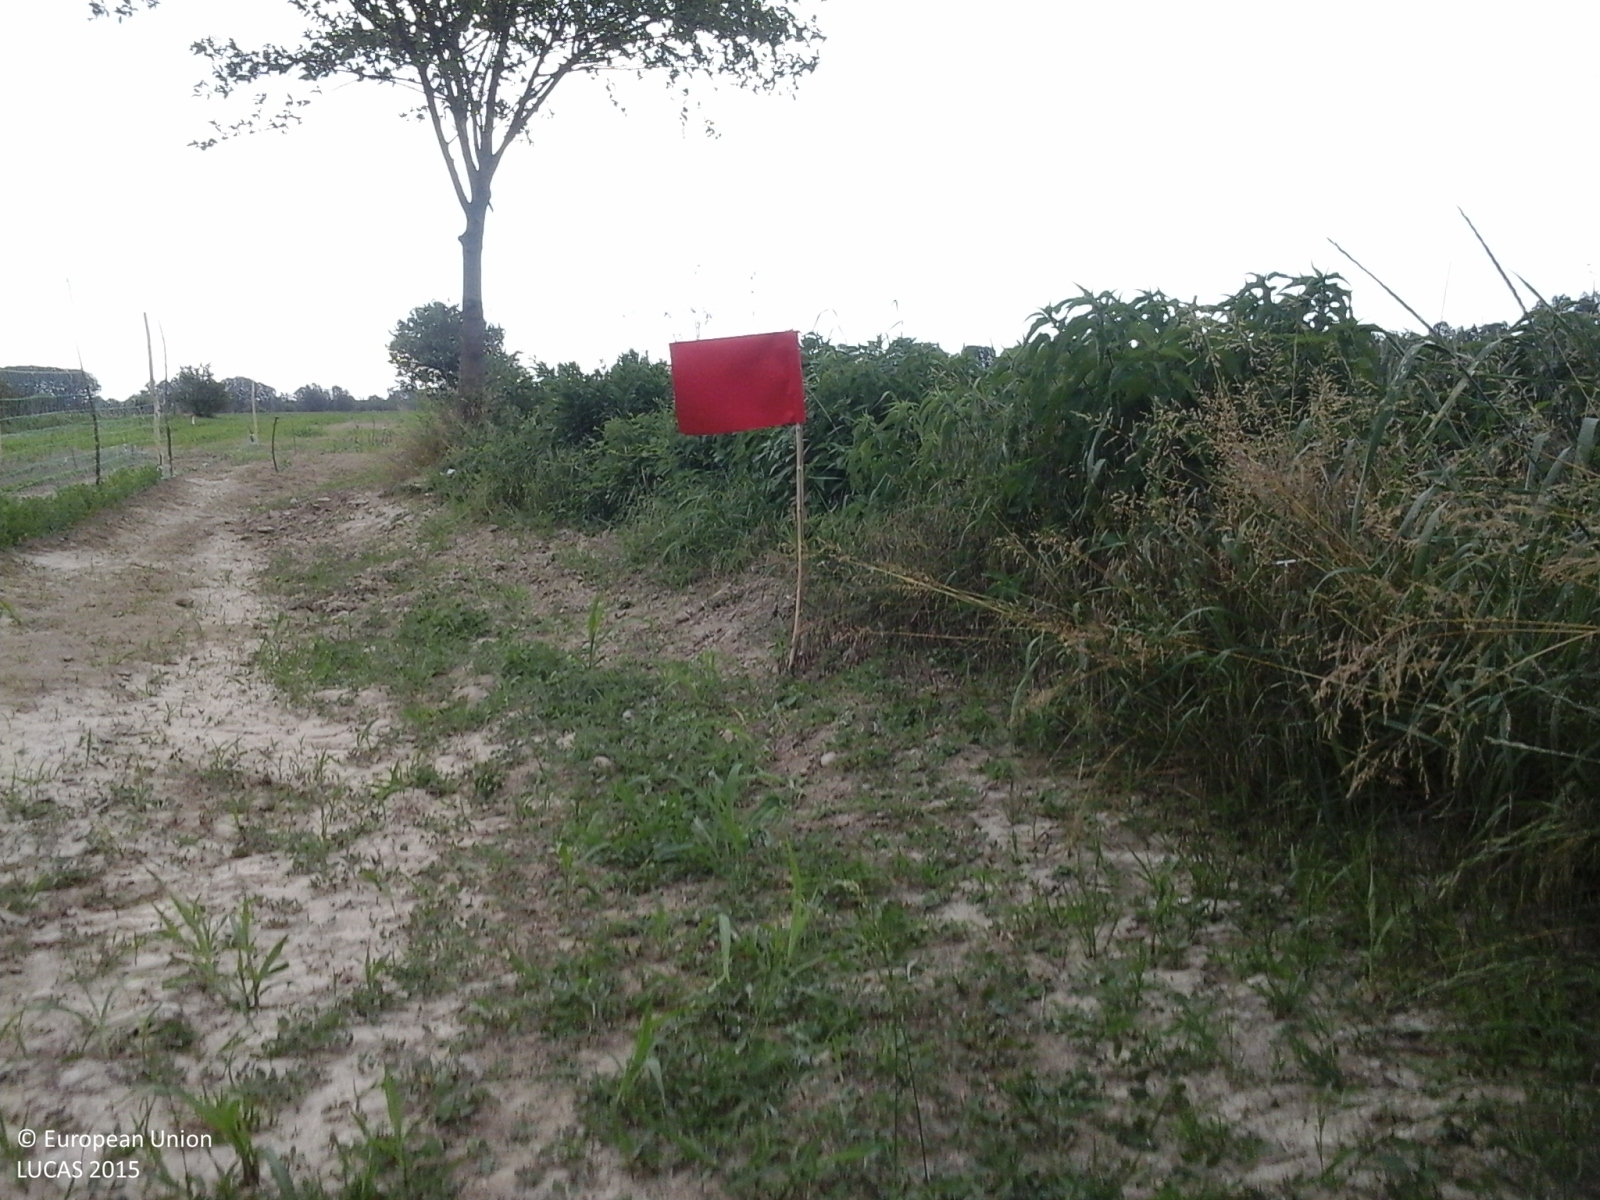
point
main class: Cropland
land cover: Other fresh vegetables
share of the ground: < 10 %
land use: Kitchen garden
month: May
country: IT
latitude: 44.8796
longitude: 8.4207
